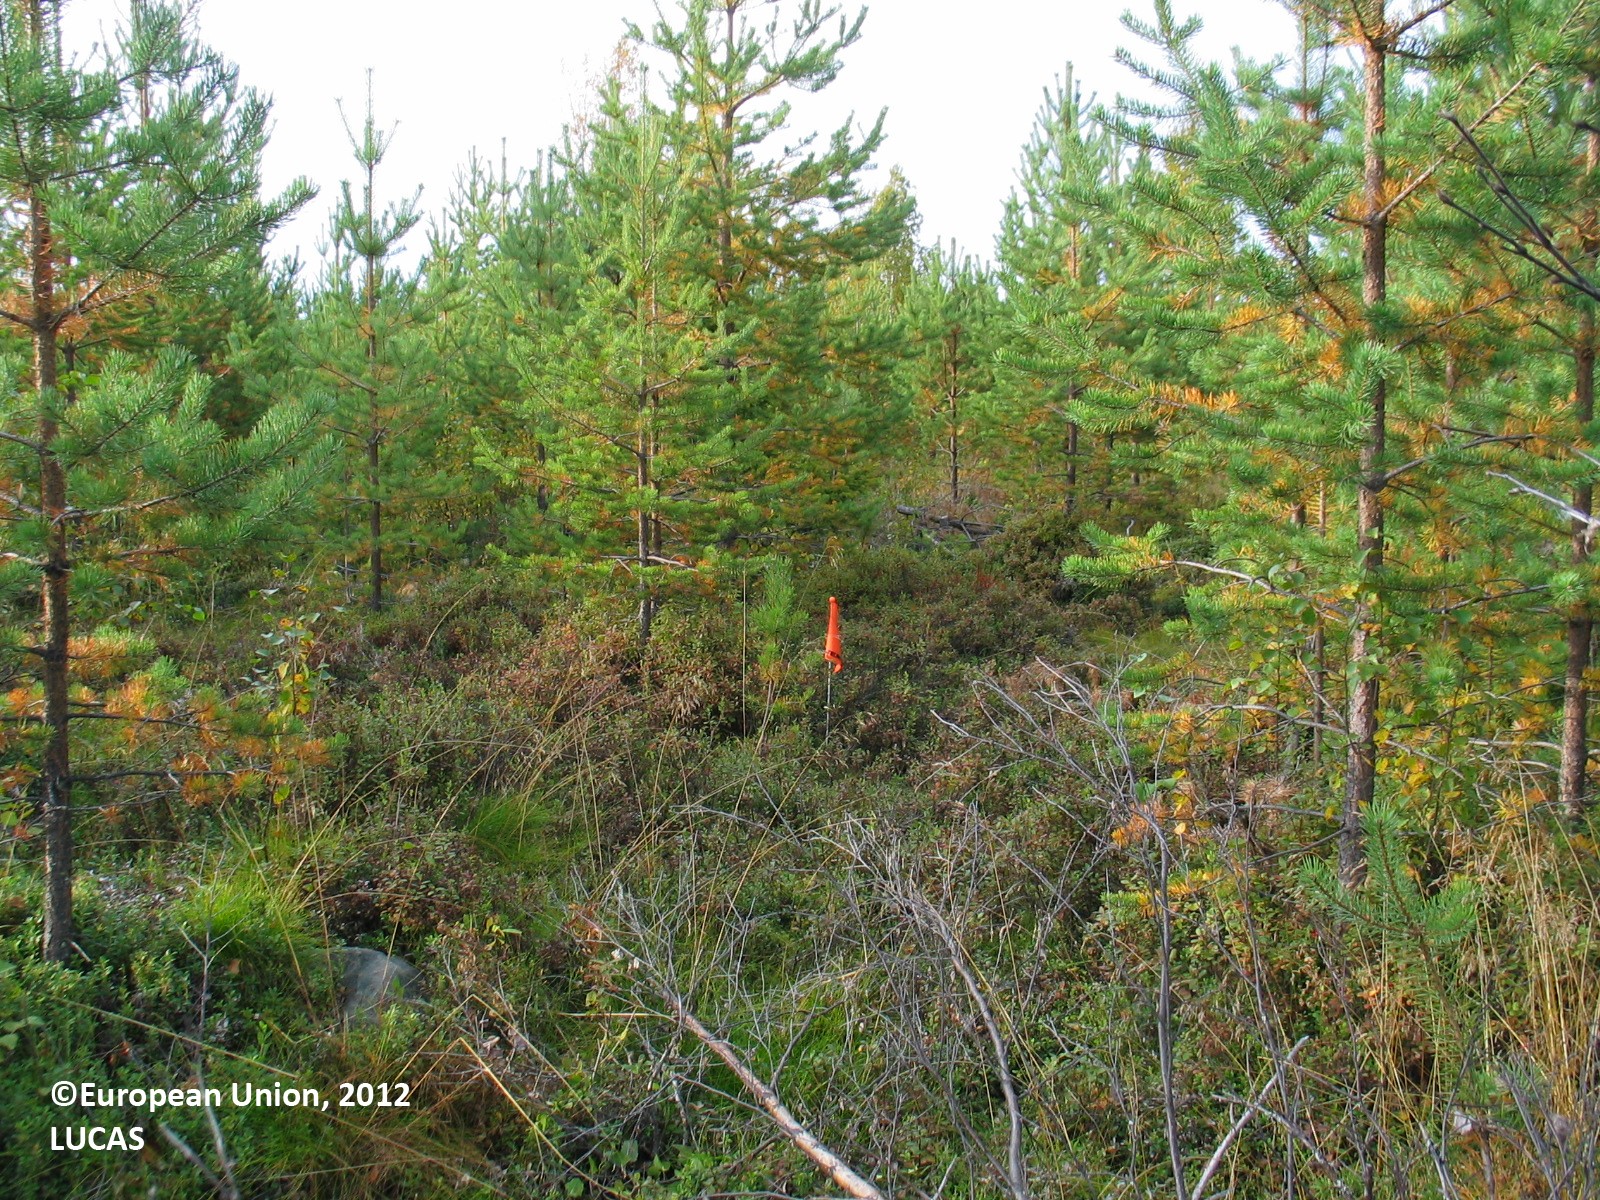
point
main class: Woodland
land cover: Pine dominated coniferous woodland
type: boreal forest
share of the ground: 50 - 75 %
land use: Forestry
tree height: < 5 m
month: September
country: FI
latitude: 65.2517
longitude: 25.5601
